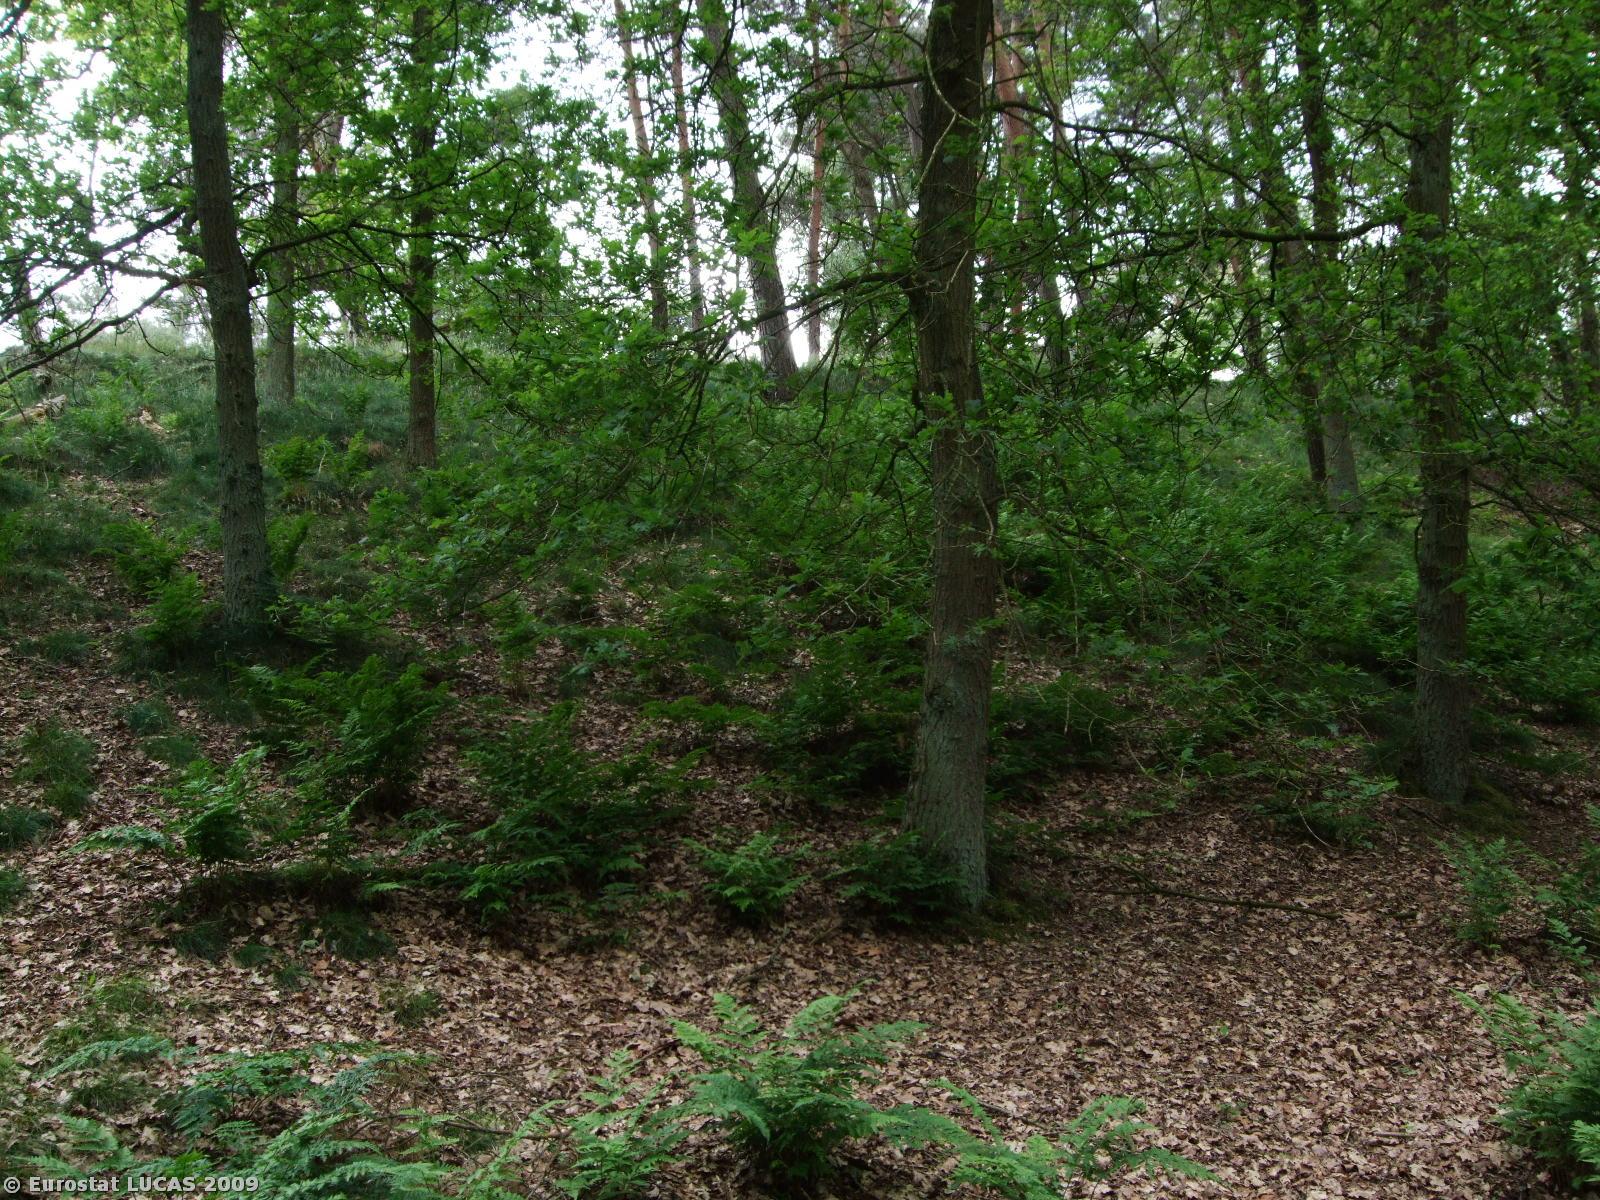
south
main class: Woodland
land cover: Mixed woodland
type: mesophytic deciduous forest
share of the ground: > 75 %
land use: Nature reserves
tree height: > 5 m
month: May
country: NL
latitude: 51.5063
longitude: 6.1812
